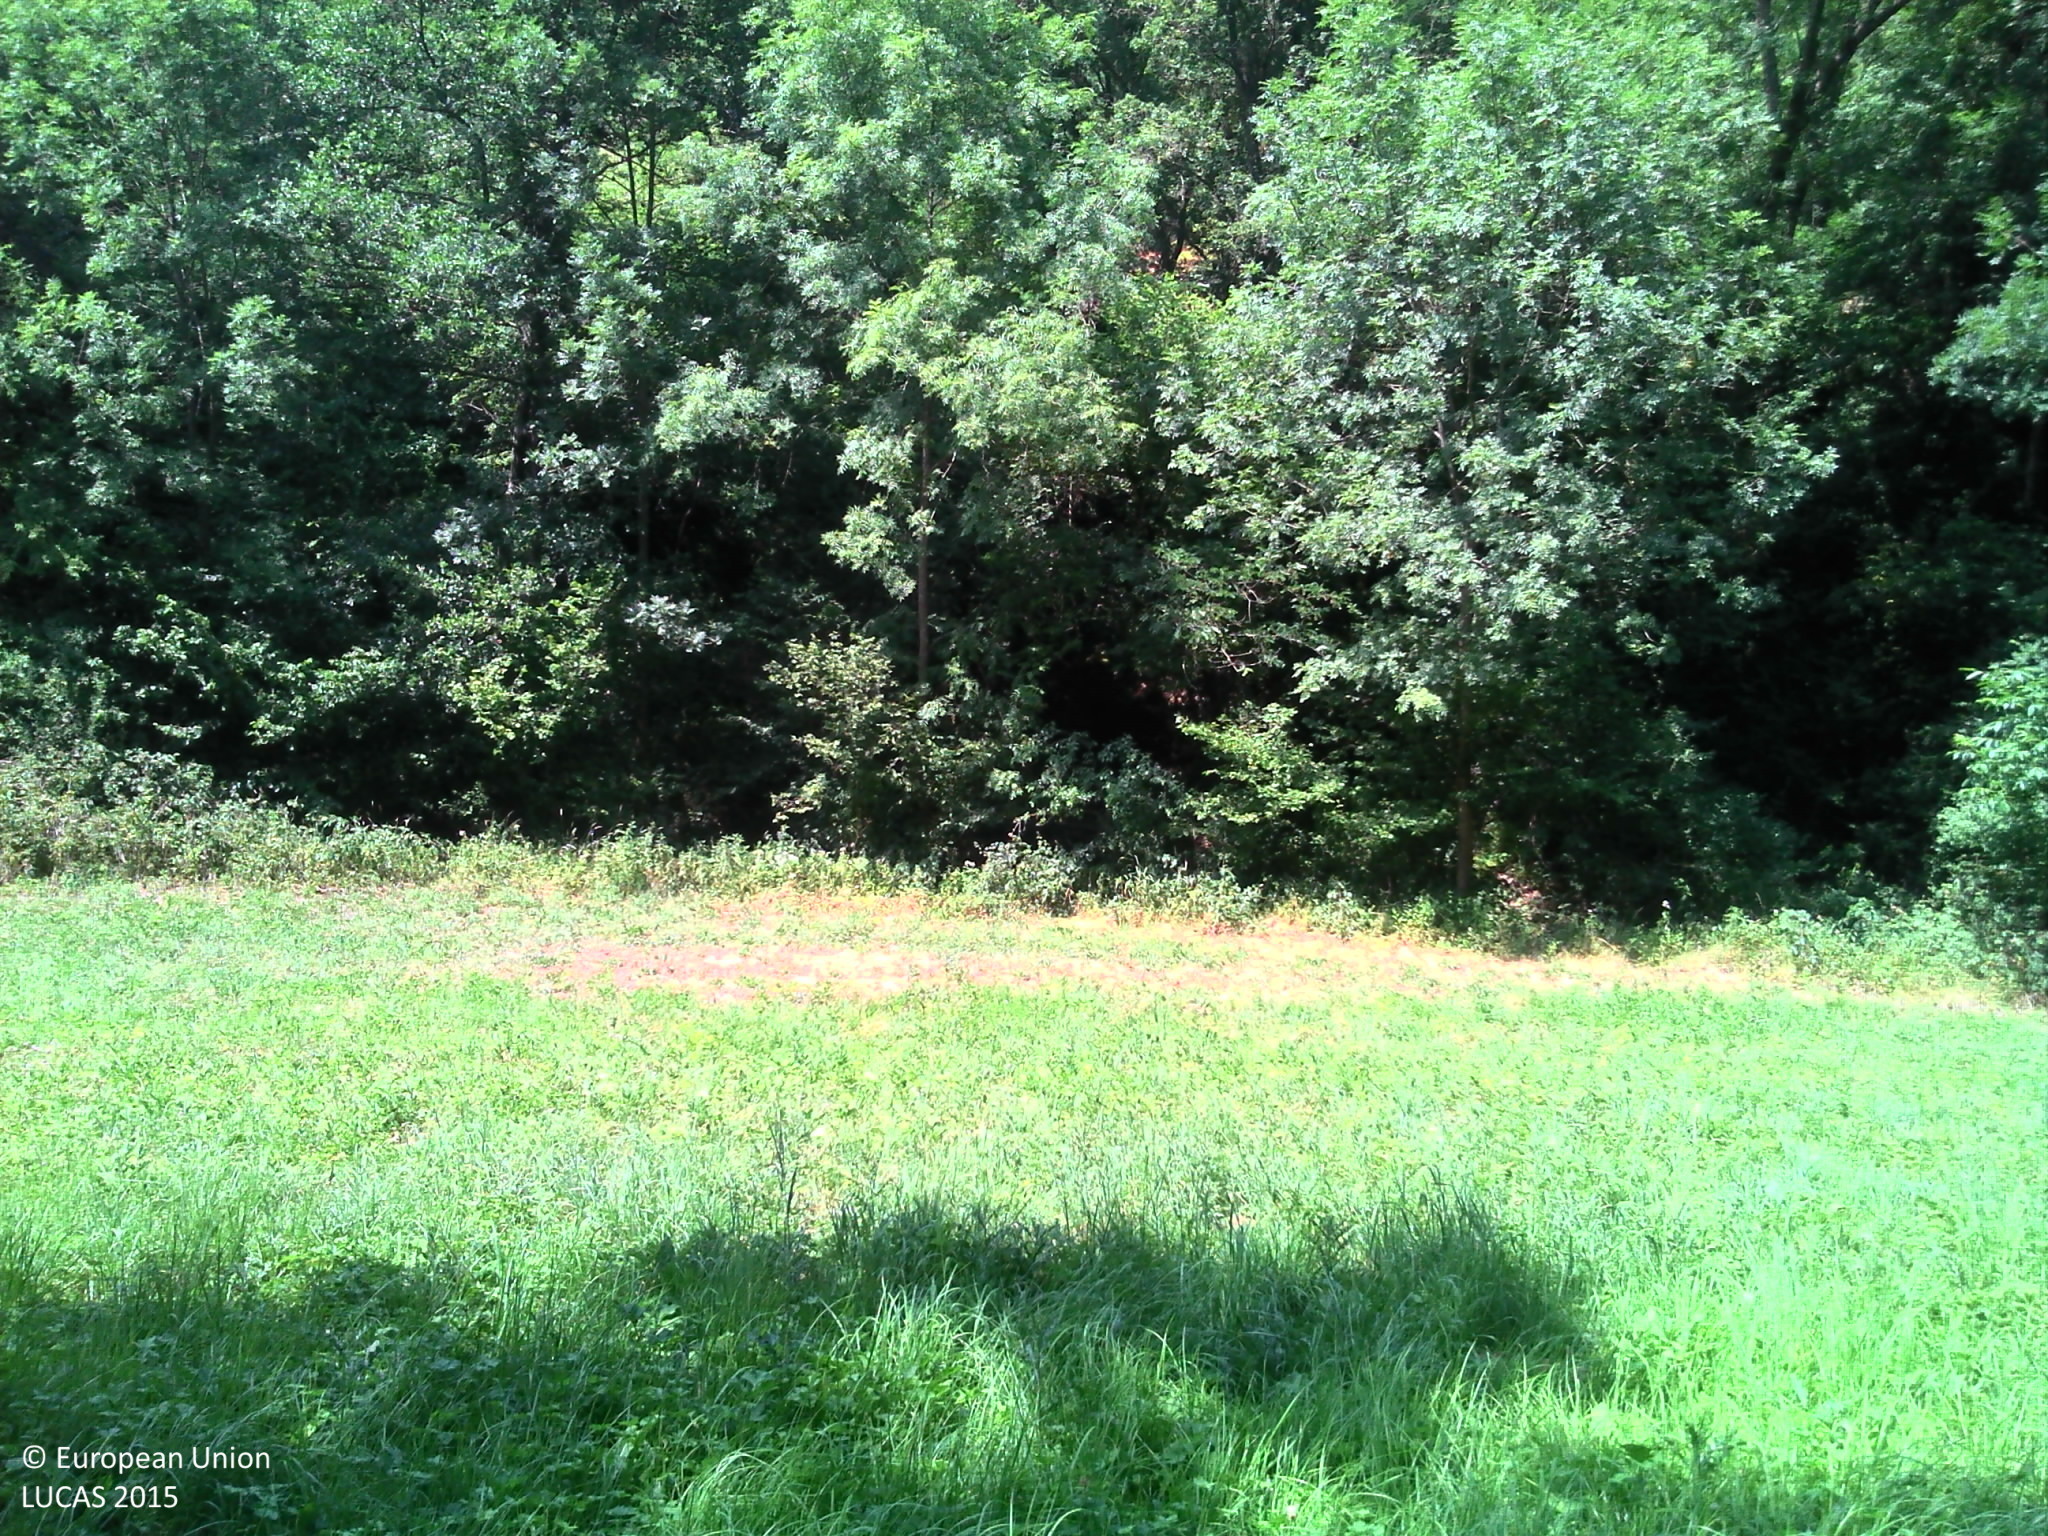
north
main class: Woodland
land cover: Broadleaved woodland
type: mesophytic deciduous forest
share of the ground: > 75 %
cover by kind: broadleaved forest trees 100 %
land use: Forestry
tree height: > 5 m
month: July
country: FR
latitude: 45.2855
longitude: 3.2063
